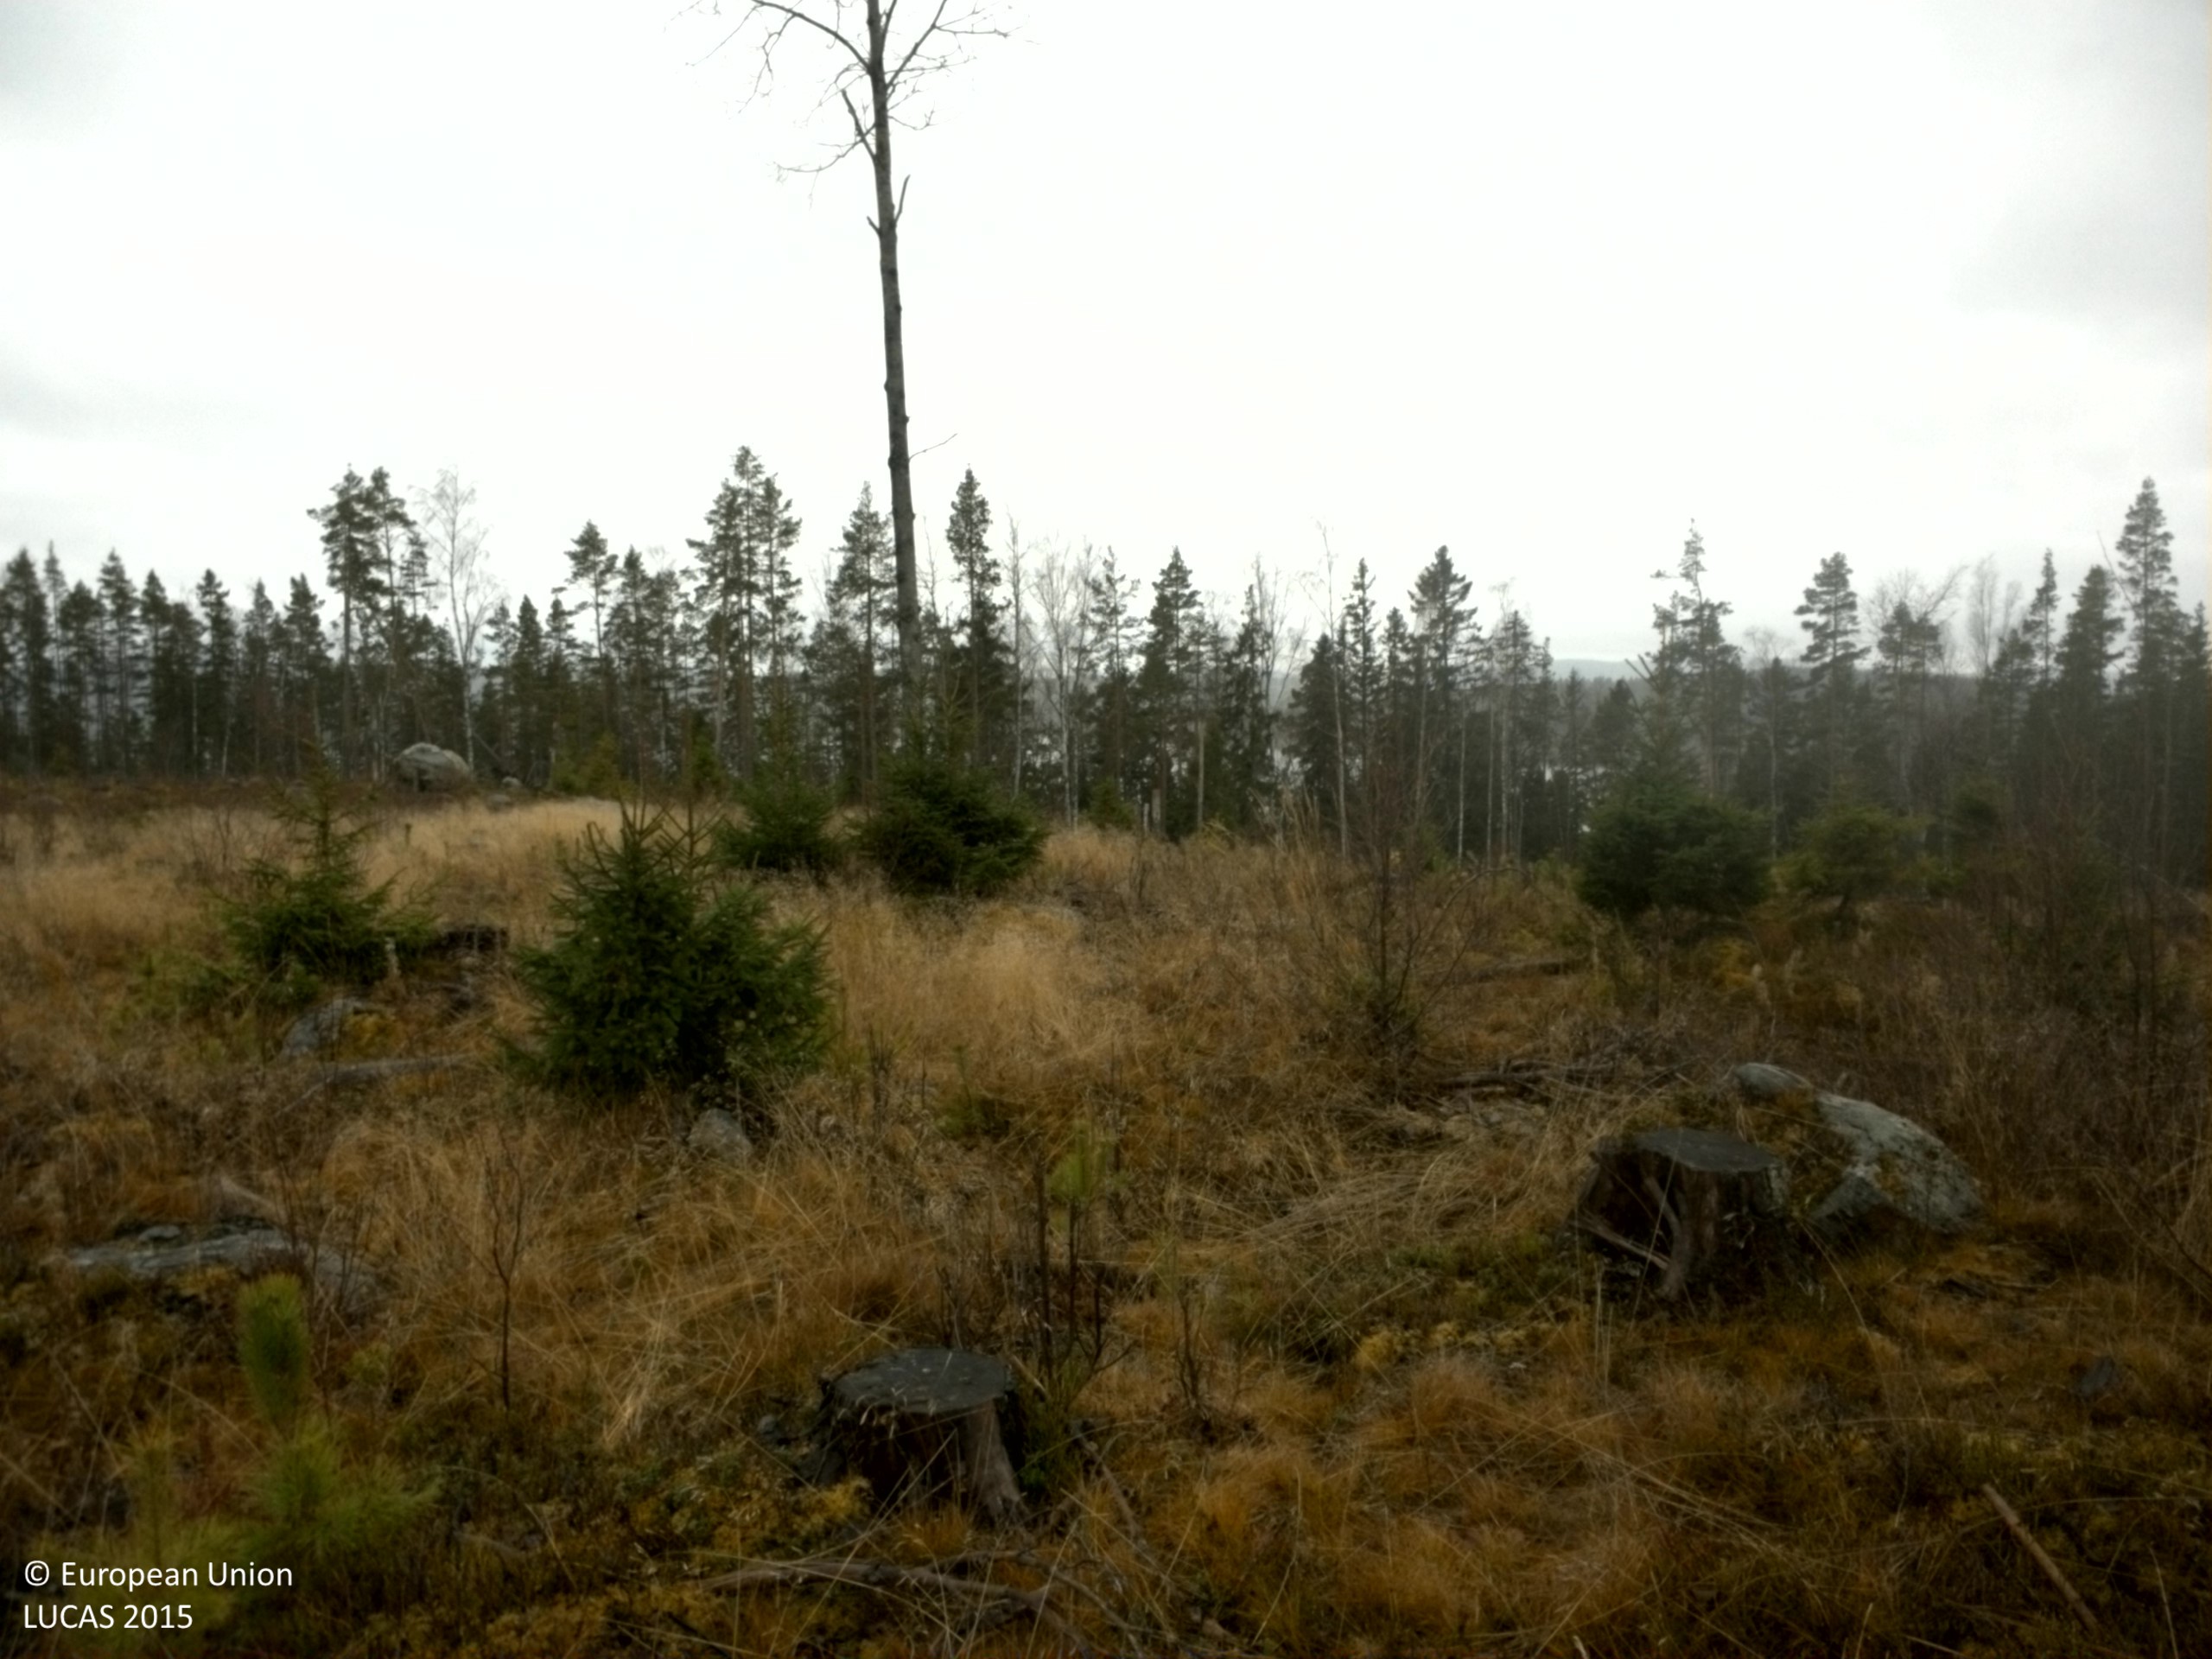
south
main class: Woodland
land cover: Other mixed woodland
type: boreal forest
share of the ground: 10 - 25 %
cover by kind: herbaceous plants 40 %, lichens and mosses 20 %, shrubs 15 %, coniferous forest trees 10 %, broadleaved forest trees 10 %, consolidated bare surface 5 %
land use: Forestry
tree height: < 5 m
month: November
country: SE
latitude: 61.6009
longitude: 16.5616
